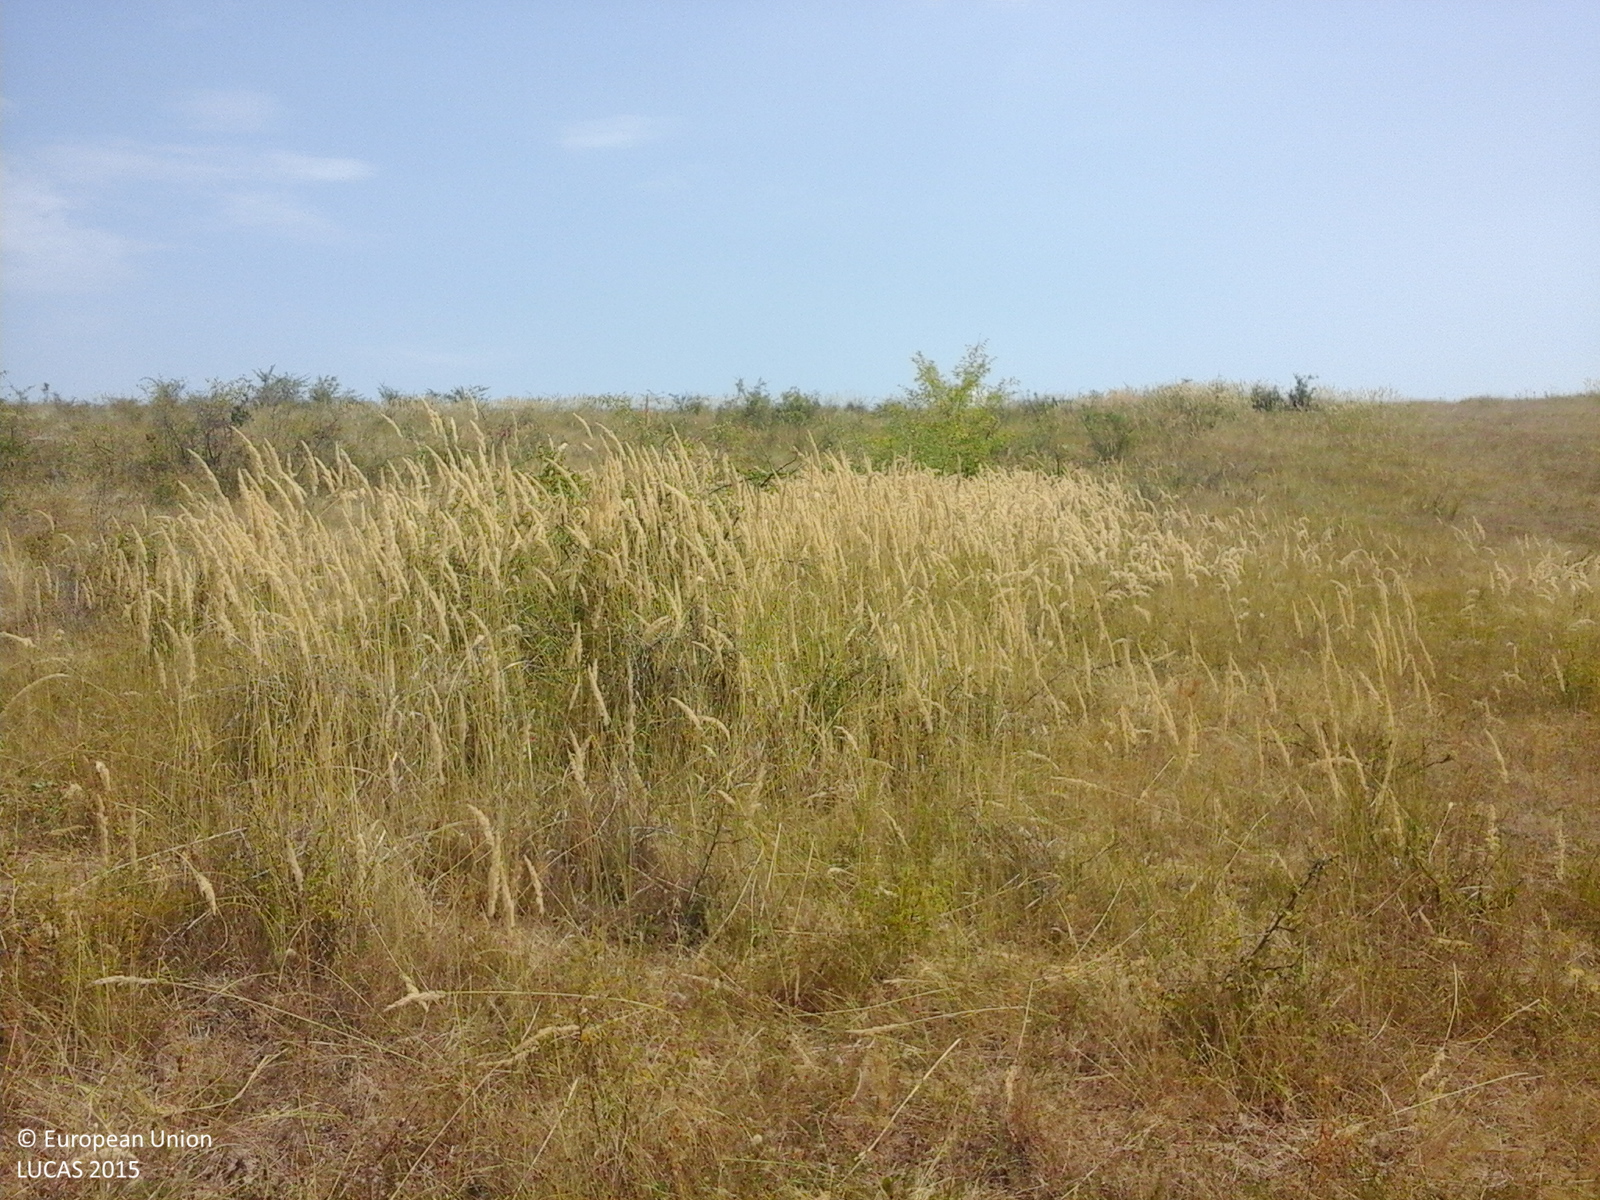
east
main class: Grassland
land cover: Grassland without tree/shrub cover
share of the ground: > 75 %
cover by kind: herbaceous plants 100 %
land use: Agriculture (excluding fallow land and kitchen gardens)
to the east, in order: Grassland without tree/shrub cover; Grassland with sparse tree/shrub cover; Tracks; Grassland with sparse tree/shrub cover; Abandoned hedges; Grassland with sparse tree/shrub cover; Abandoned hedges; Grassland with sparse tree/shrub cover
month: August
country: RO
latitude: 44.5273
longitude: 23.6070
